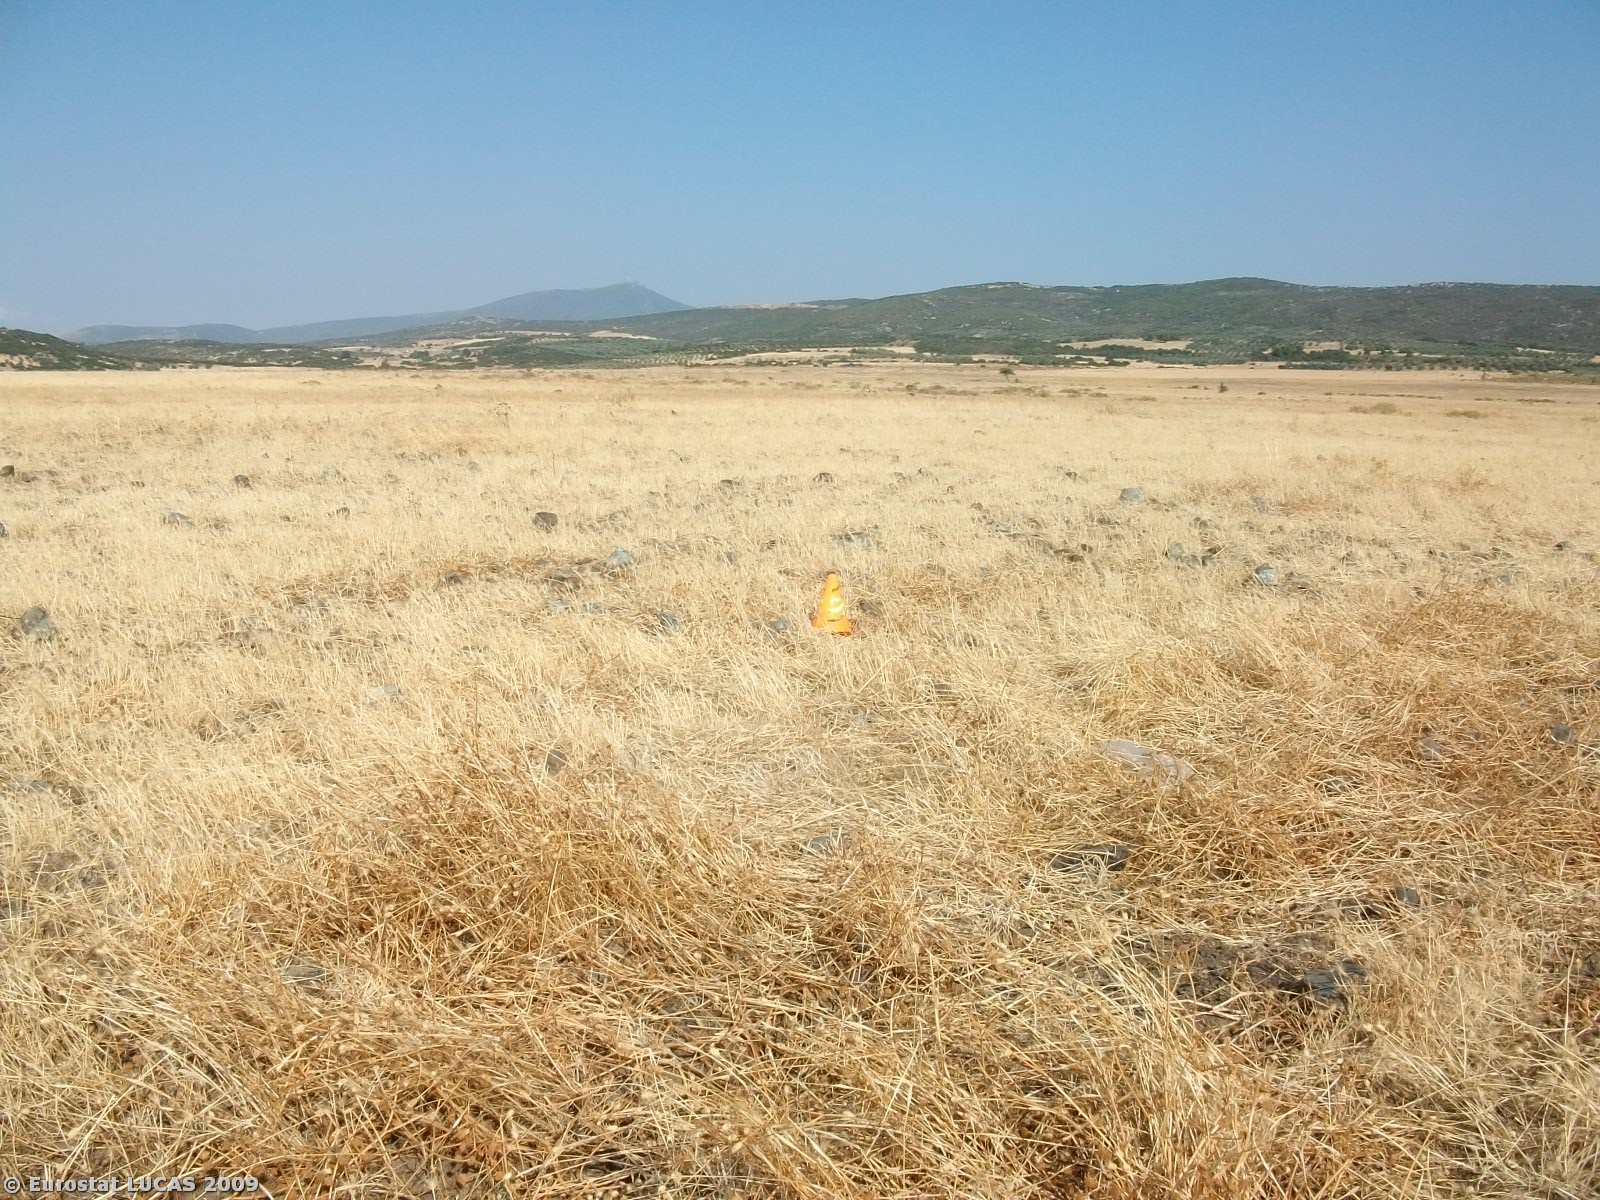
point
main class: Grassland
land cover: Grassland without tree/shrub cover
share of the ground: 50 - 75 %
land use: Unused
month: August
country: GR
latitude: 38.5577
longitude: 23.1220
